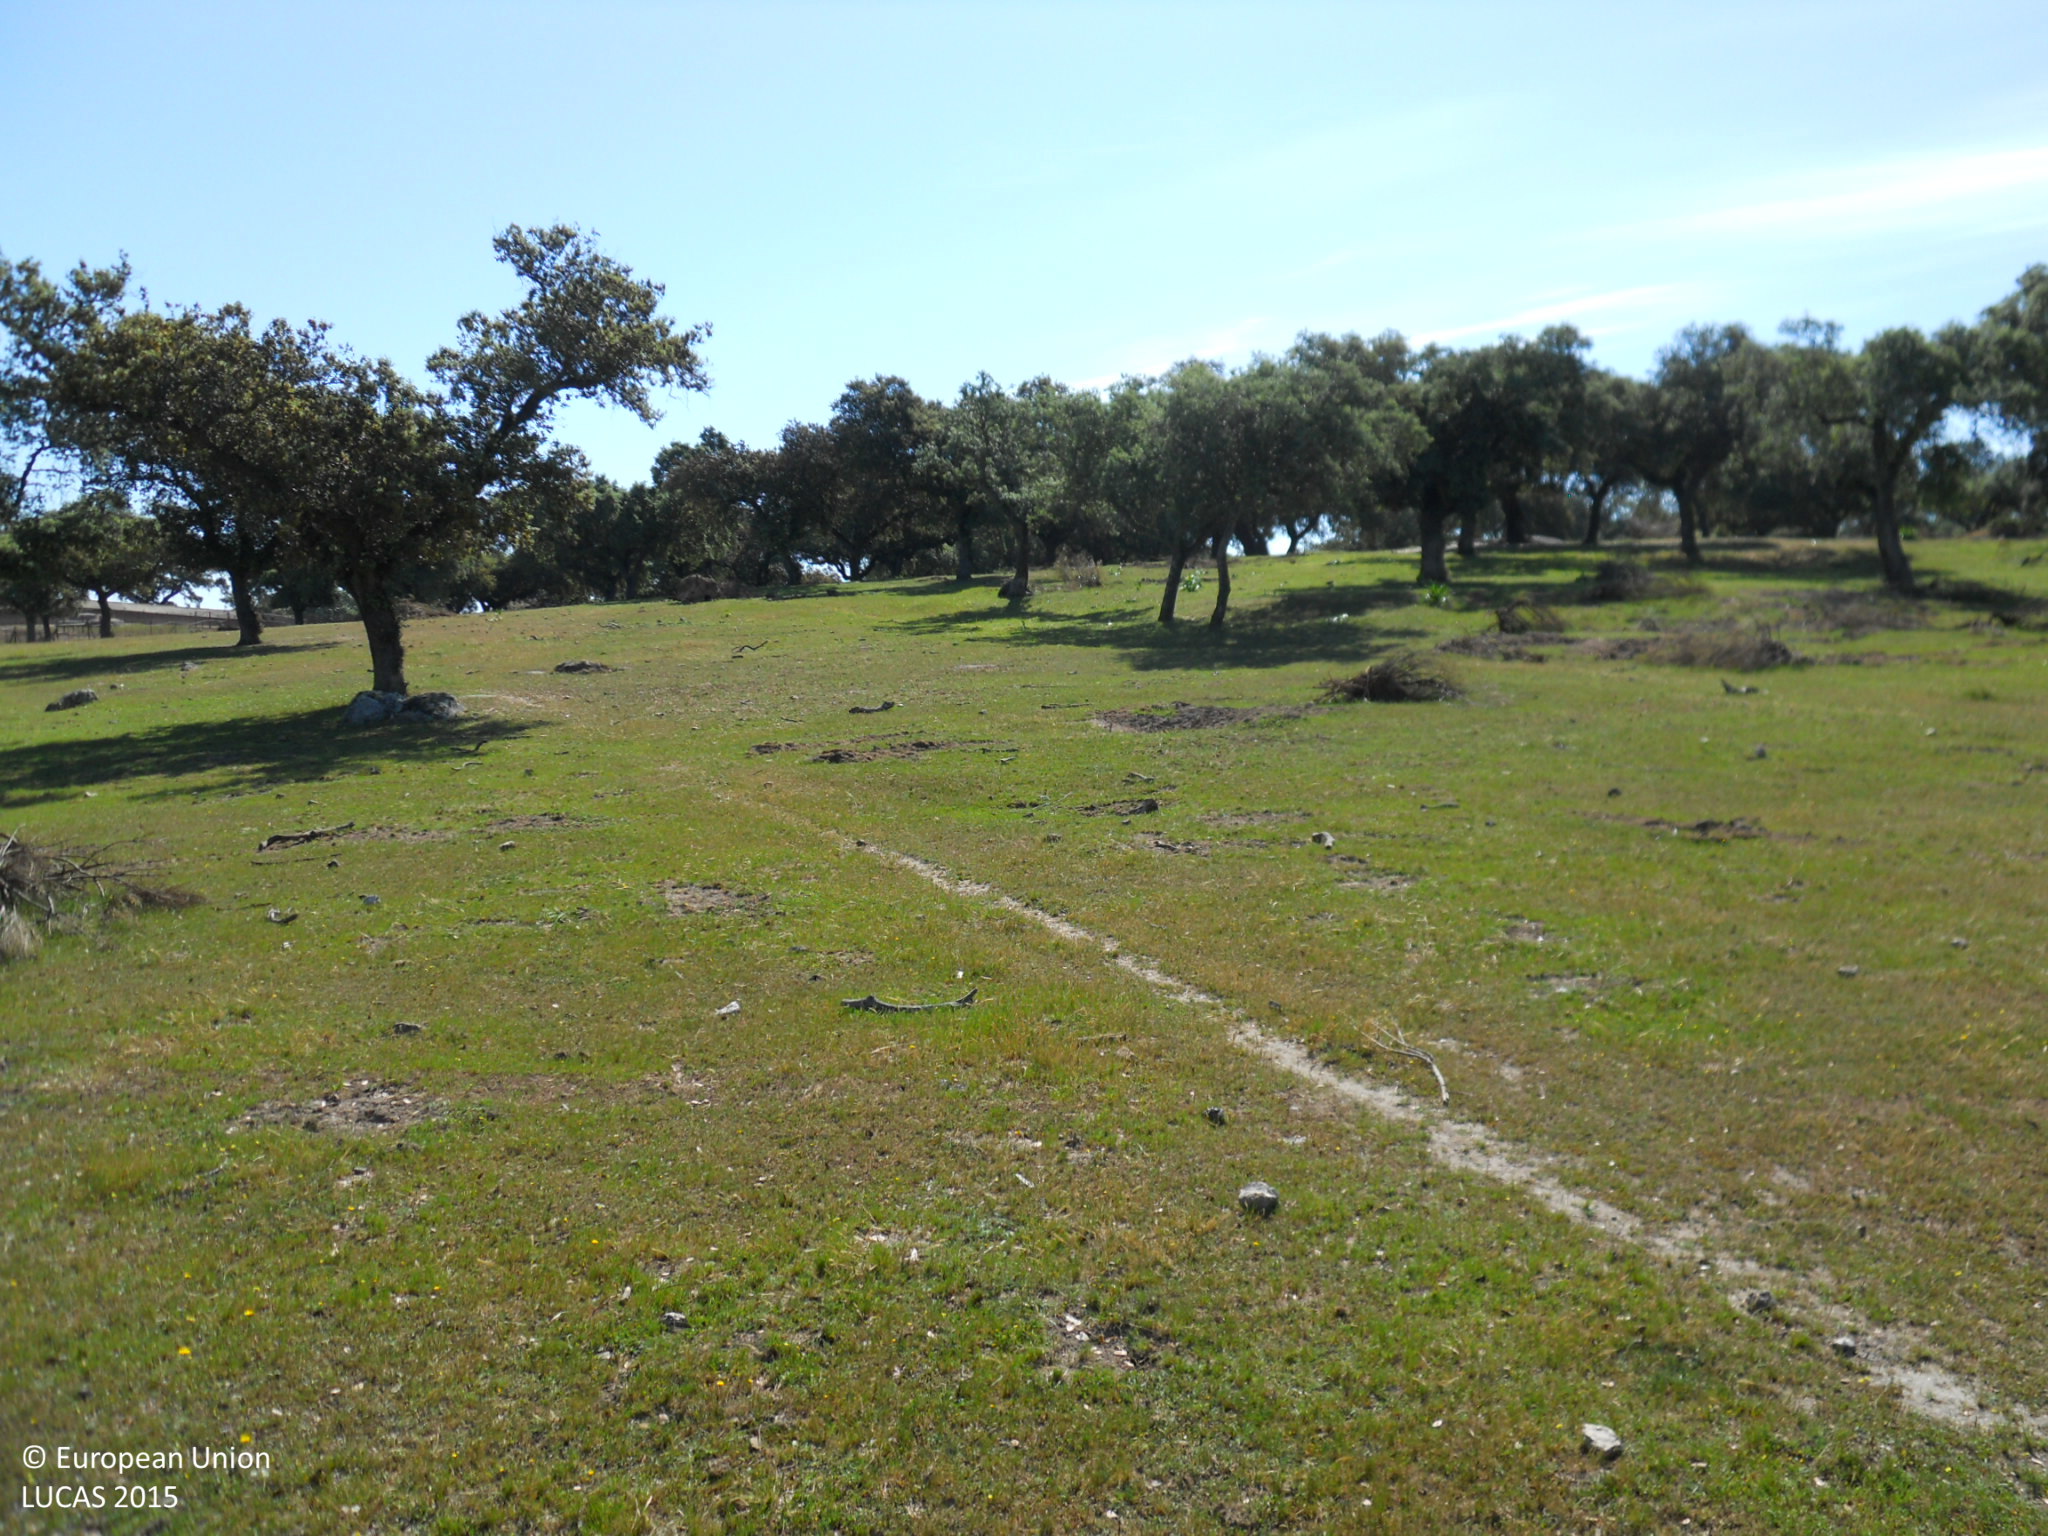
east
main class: Grassland
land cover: Grassland with sparse tree/shrub cover
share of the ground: > 75 %
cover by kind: herbaceous plants 70 %, unconsolidated bare surface 20 %, broadleaved forest trees 5 %, shrubs 5 %
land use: Agriculture (excluding fallow land and kitchen gardens)
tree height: > 5 m
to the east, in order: Grassland with sparse tree/shrub cover; Broadleaved woodland; Rock outcrops
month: April
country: ES
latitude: 39.3202
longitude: -7.0254
